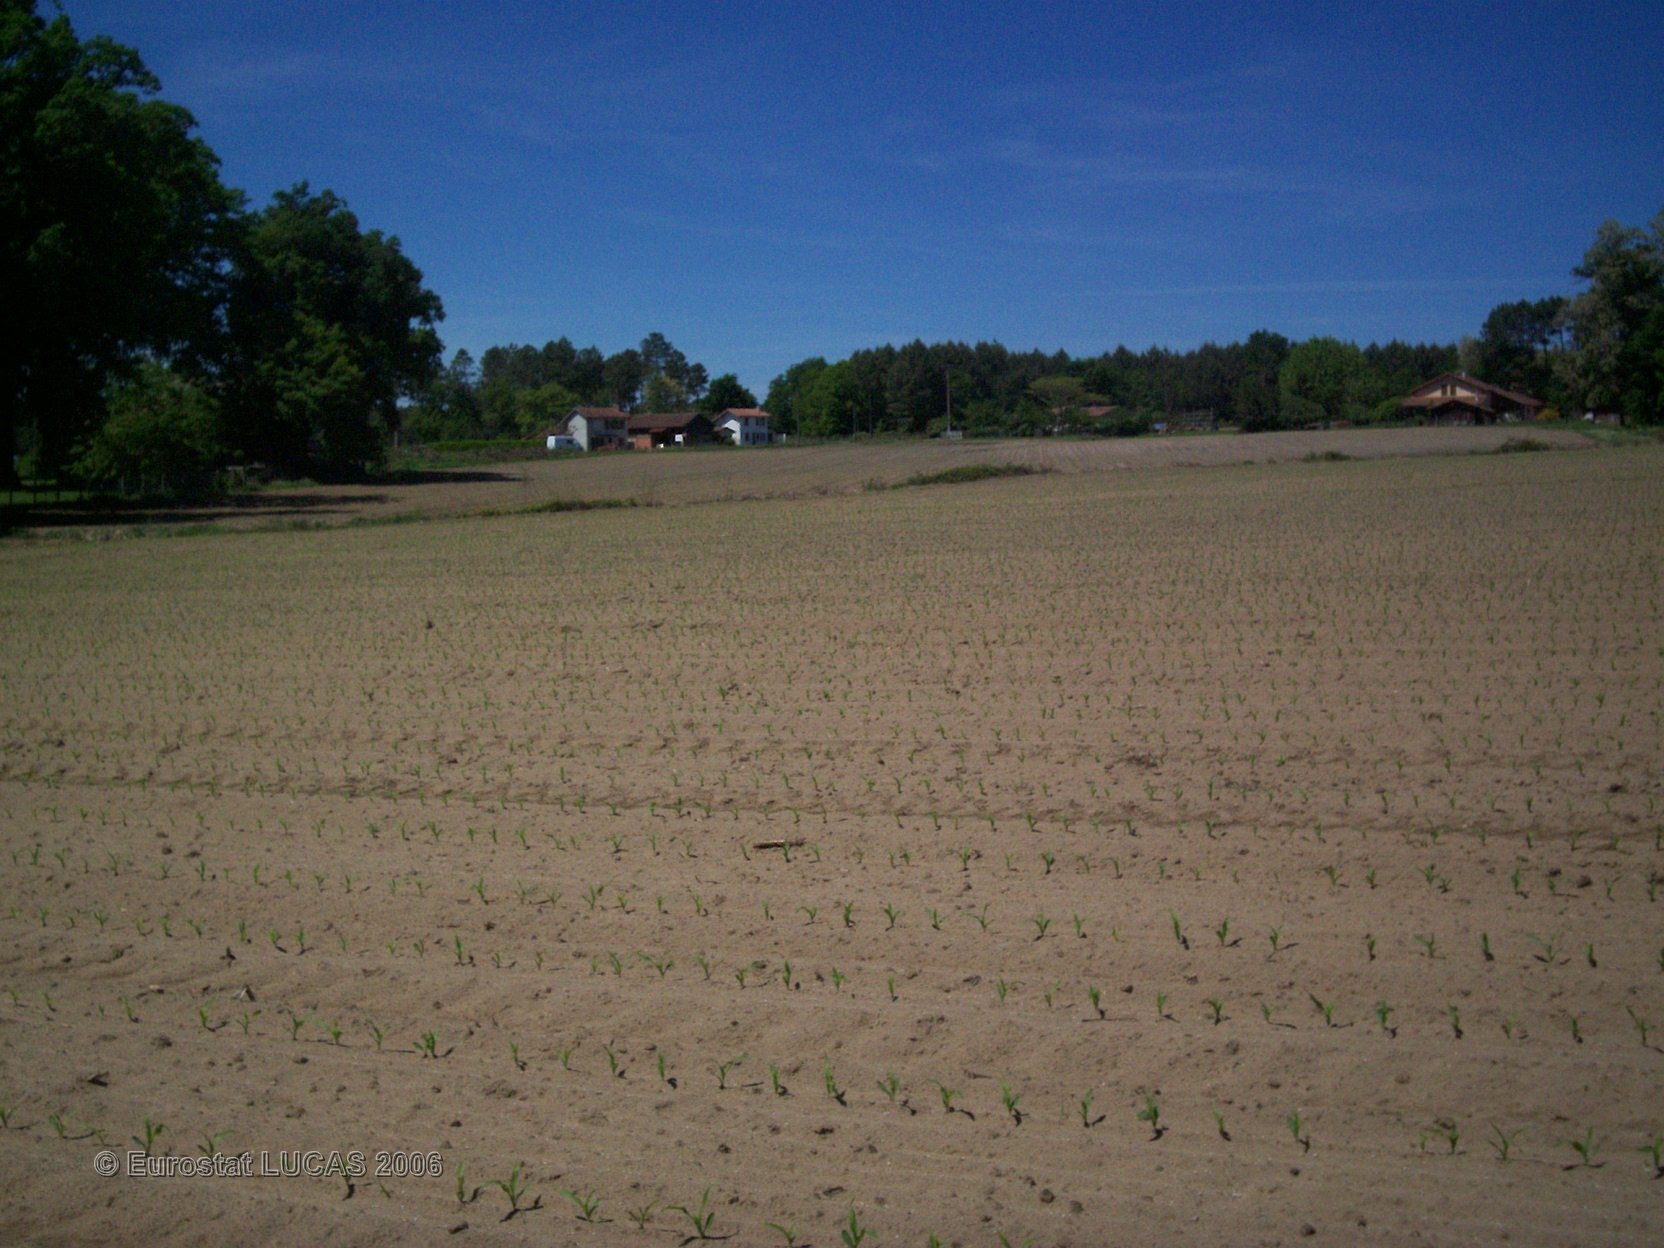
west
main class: Cropland
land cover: Maize
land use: Agriculture (excluding fallow land and kitchen gardens)
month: May
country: FR
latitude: 43.9905
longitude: -0.7505
